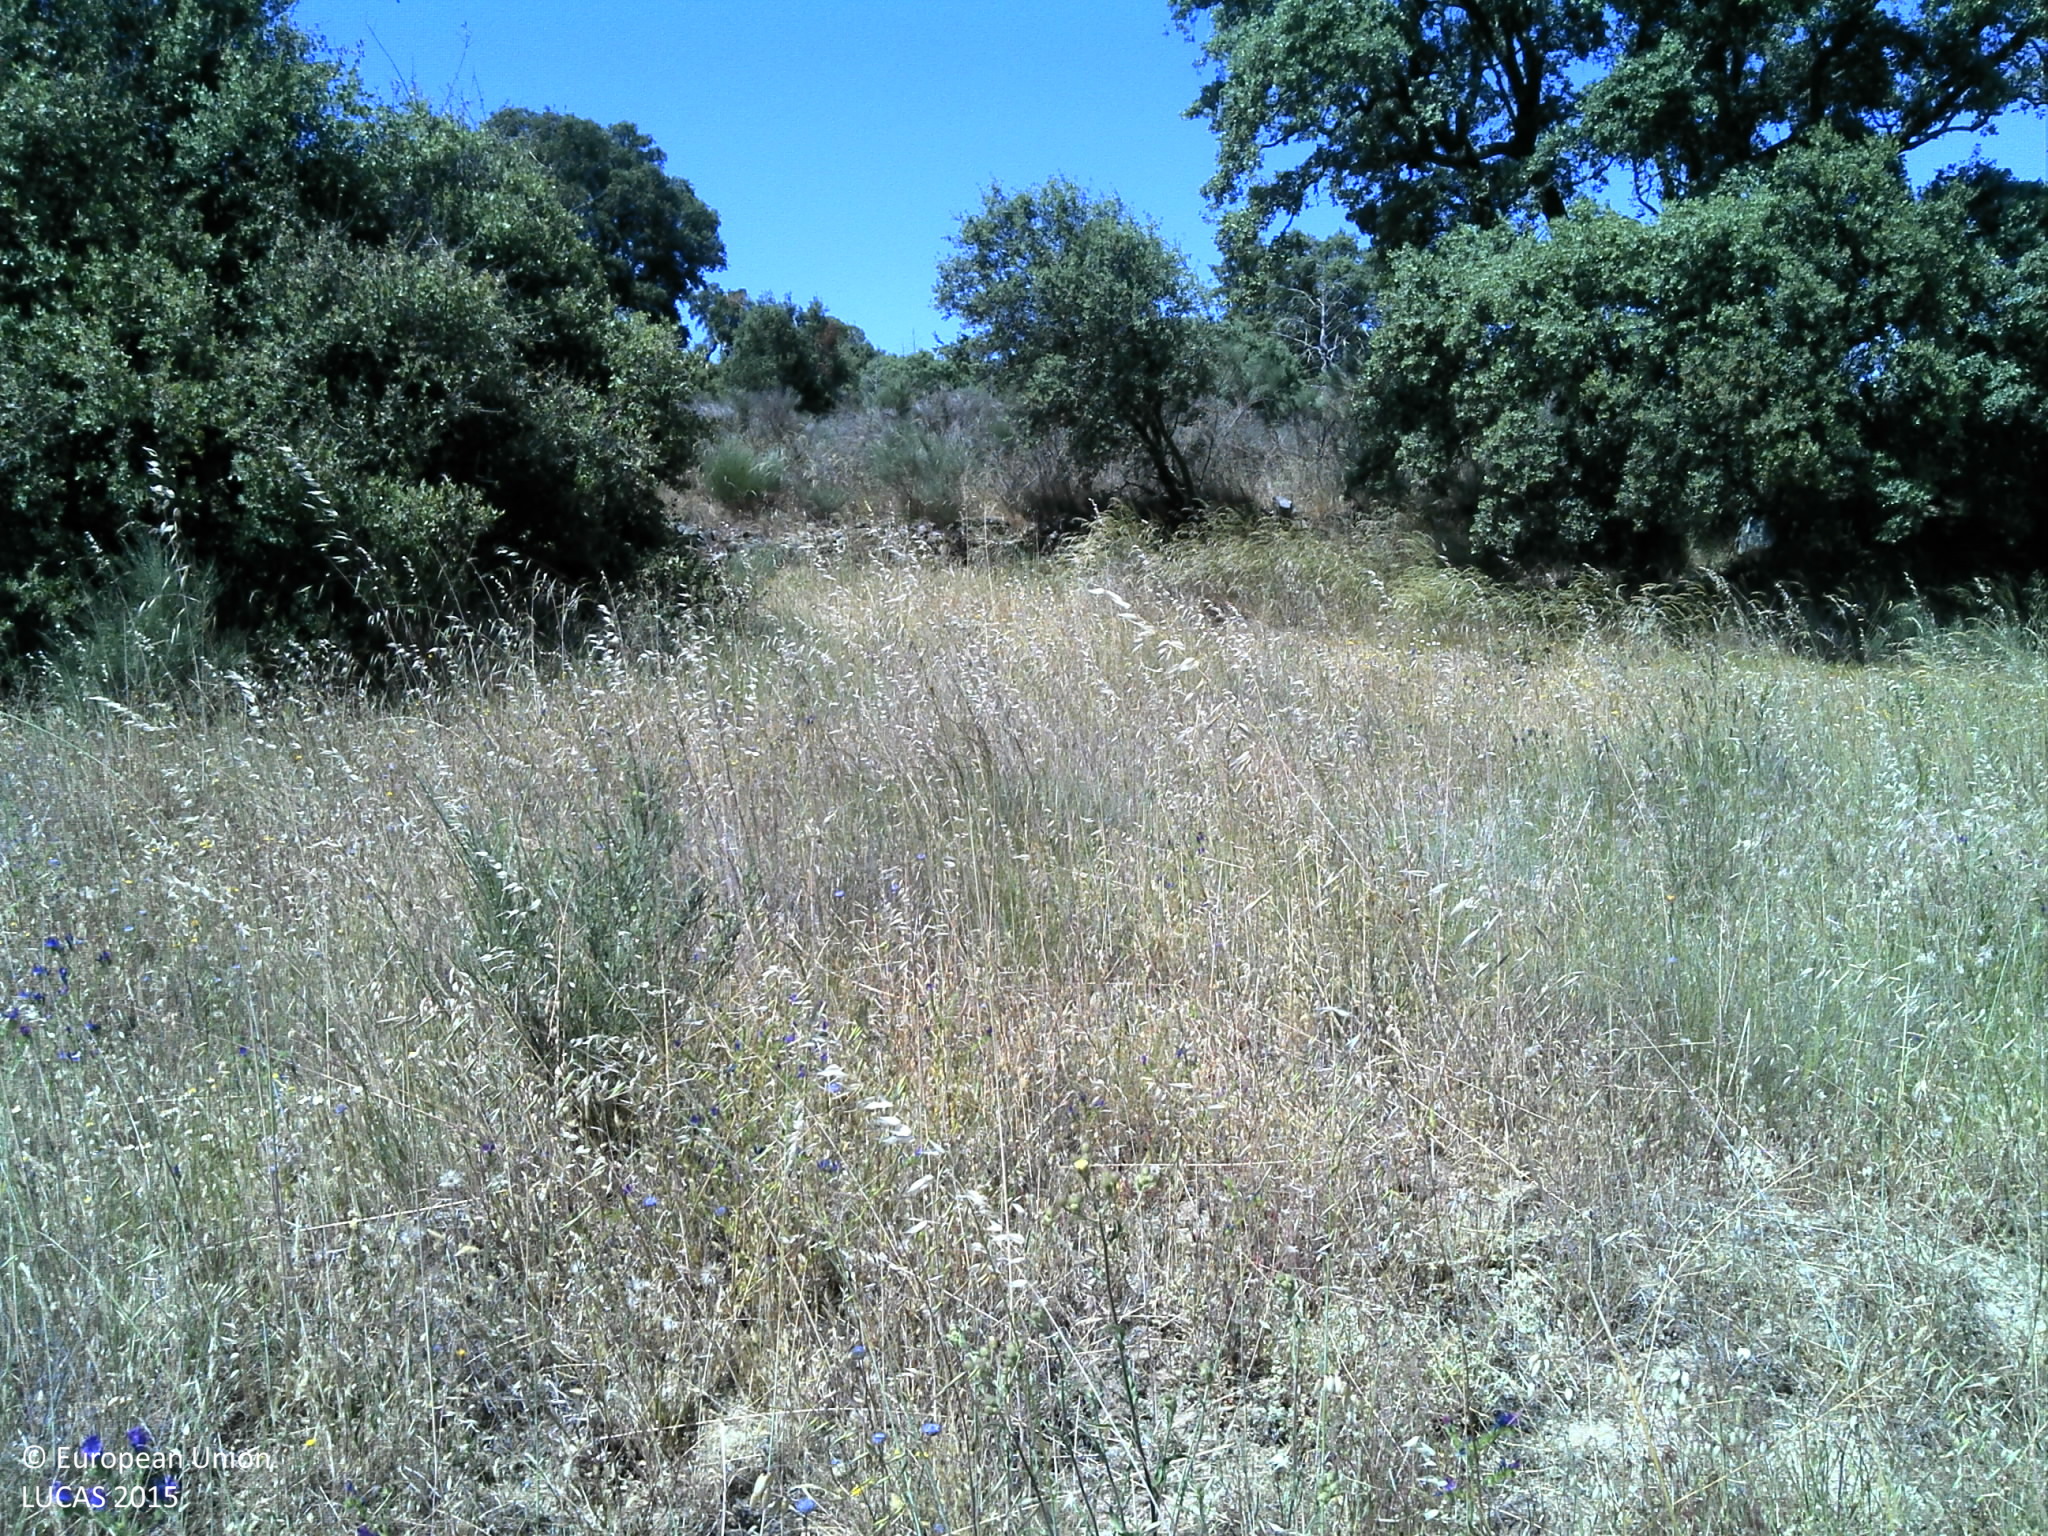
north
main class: Grassland
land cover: Grassland with sparse tree/shrub cover
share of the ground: > 75 %
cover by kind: herbaceous plants 80 %, unconsolidated bare surface 15 %, broadleaved forest trees 5 %
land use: Agriculture (excluding fallow land and kitchen gardens)
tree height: > 5 m
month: May
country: PT
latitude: 41.4276
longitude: -6.3360
